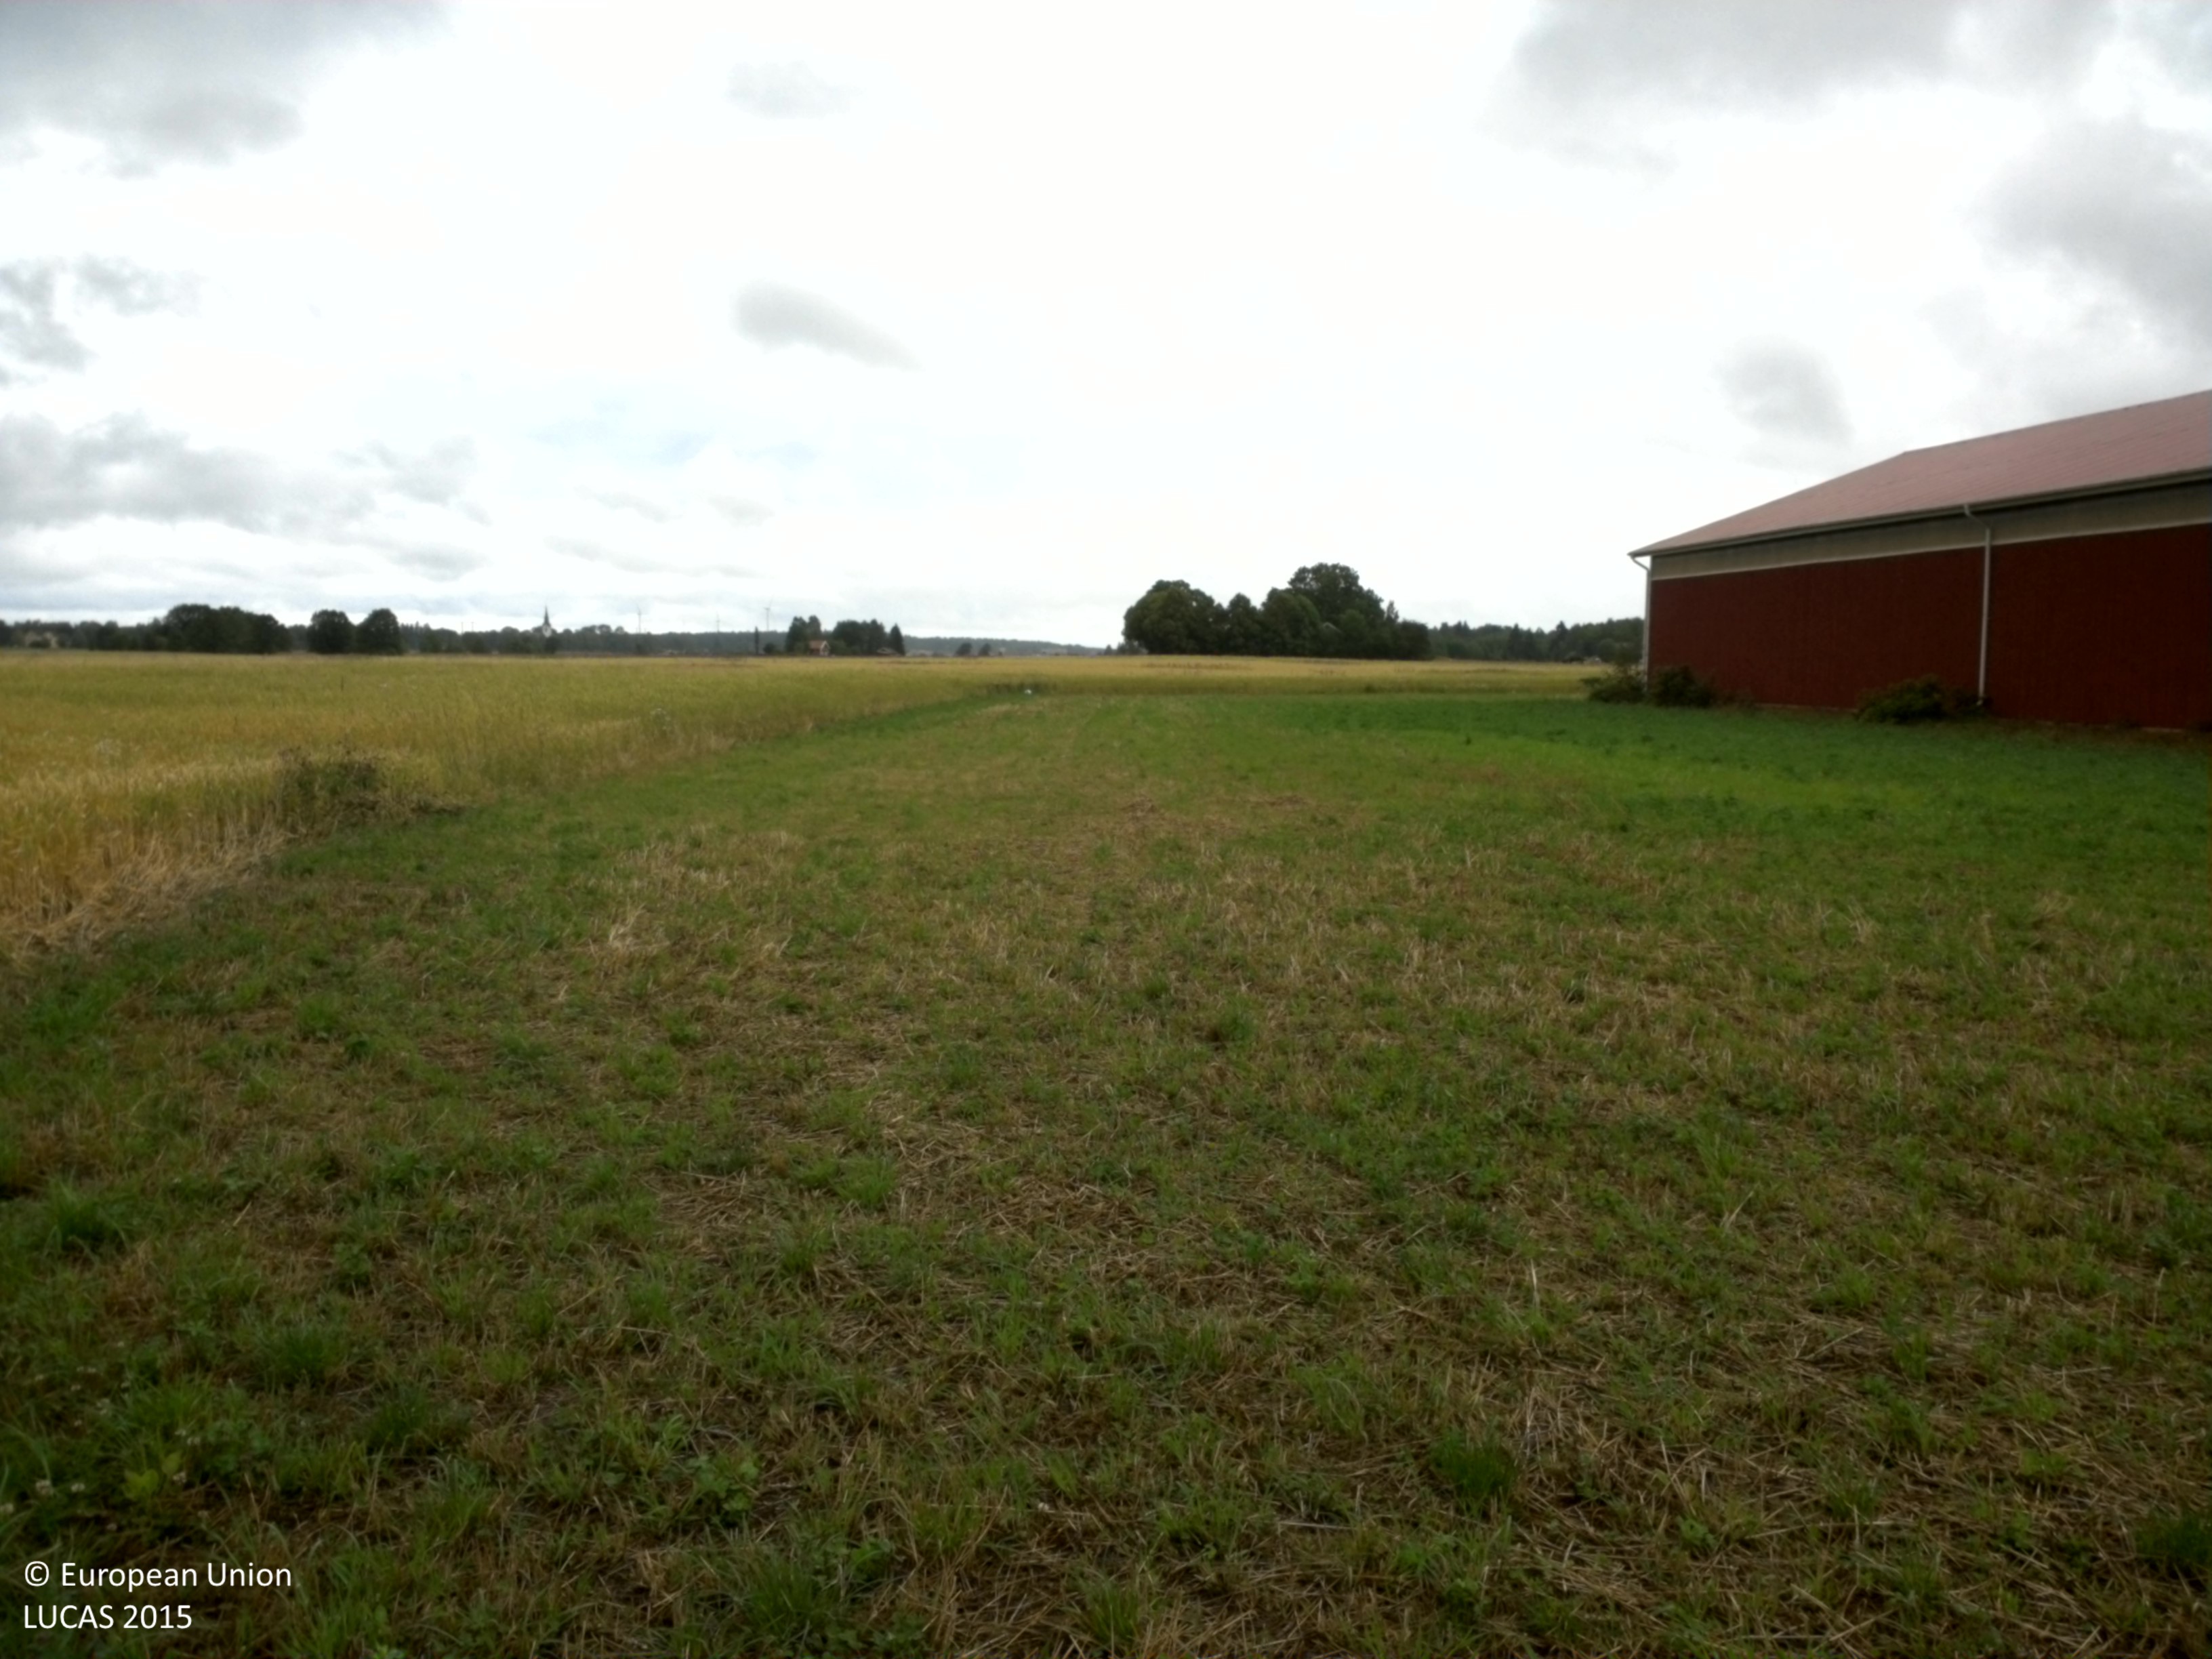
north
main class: Cropland
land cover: Barley
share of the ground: 25 - 50 %
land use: Agriculture (excluding fallow land and kitchen gardens)
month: July
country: SE
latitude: 58.7379
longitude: 13.9493
